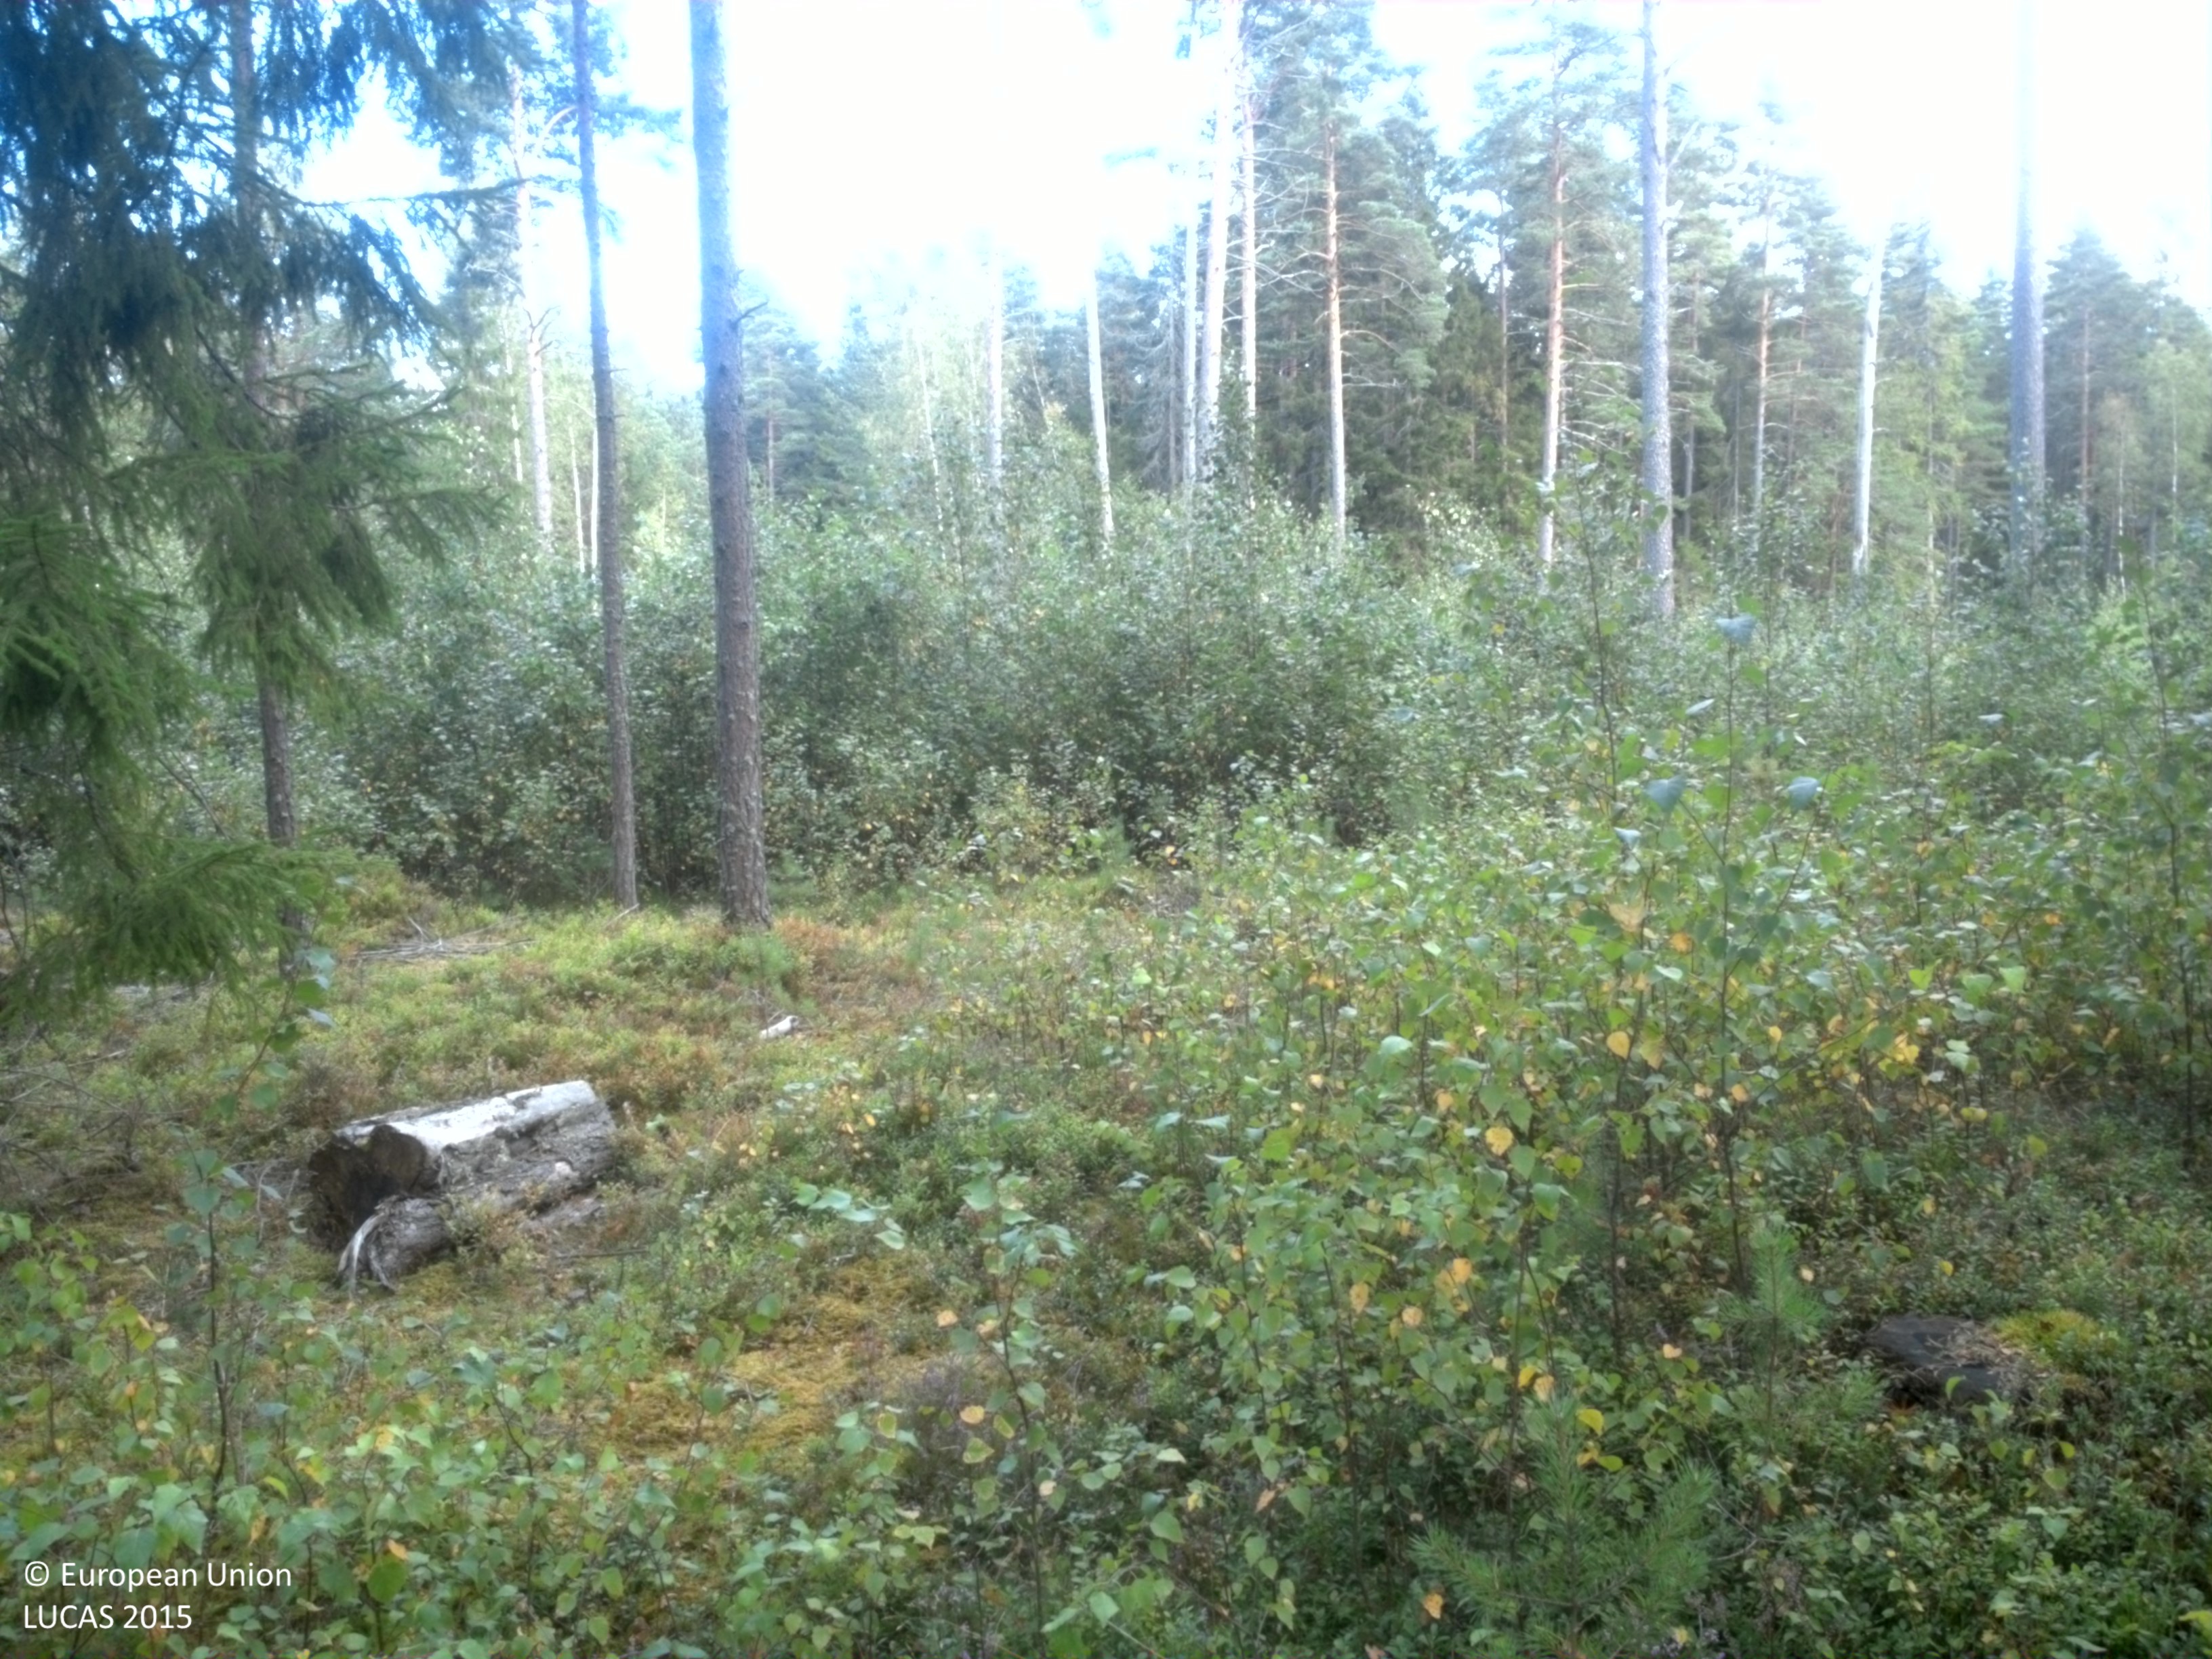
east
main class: Woodland
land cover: Pine dominated coniferous woodland
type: boreal forest
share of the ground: 50 - 75 %
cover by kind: coniferous forest trees 45 %, shrubs 30 %, lichens and mosses 20 %, broadleaved forest trees 5 %
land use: Forestry
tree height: > 5 m
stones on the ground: < 10 %
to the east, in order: Pine dominated coniferous woodland; Pine dominated mixed woodland; Tracks; Other mixed woodland; Pine dominated mixed woodland; Other coniferous woodland
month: August
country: SE
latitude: 59.4551
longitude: 15.6188
